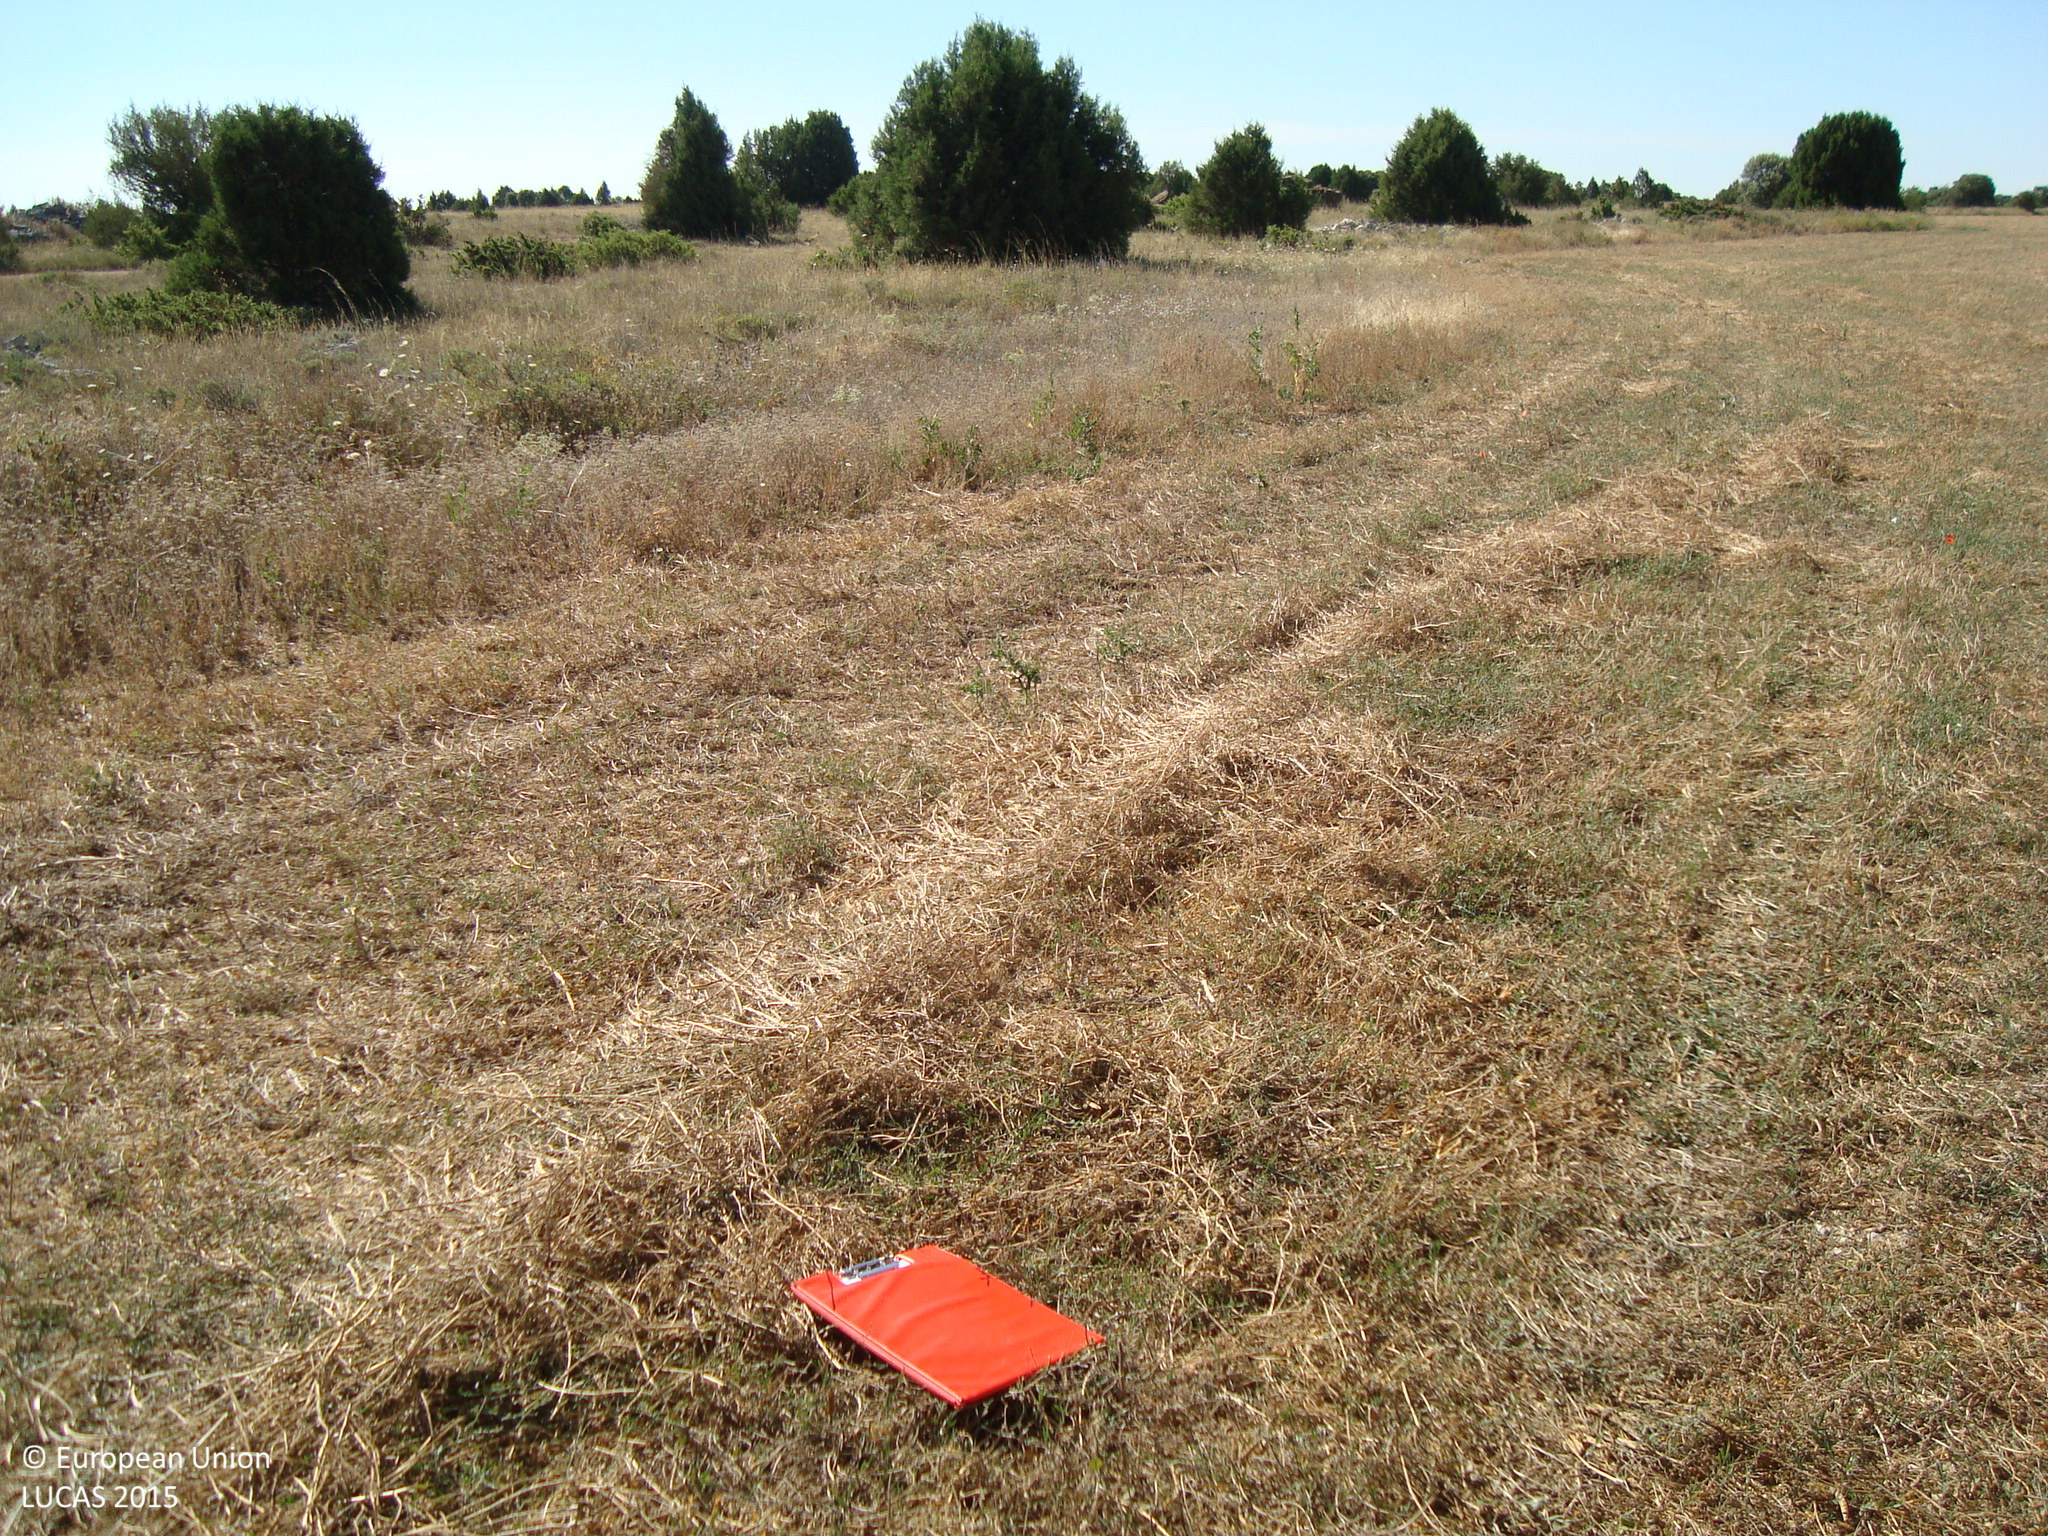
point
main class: Cropland
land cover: Dry pulses
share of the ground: > 75 %
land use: Agriculture (excluding fallow land and kitchen gardens)
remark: Harvested field
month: July
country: ES
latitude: 41.9028
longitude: -4.0808
